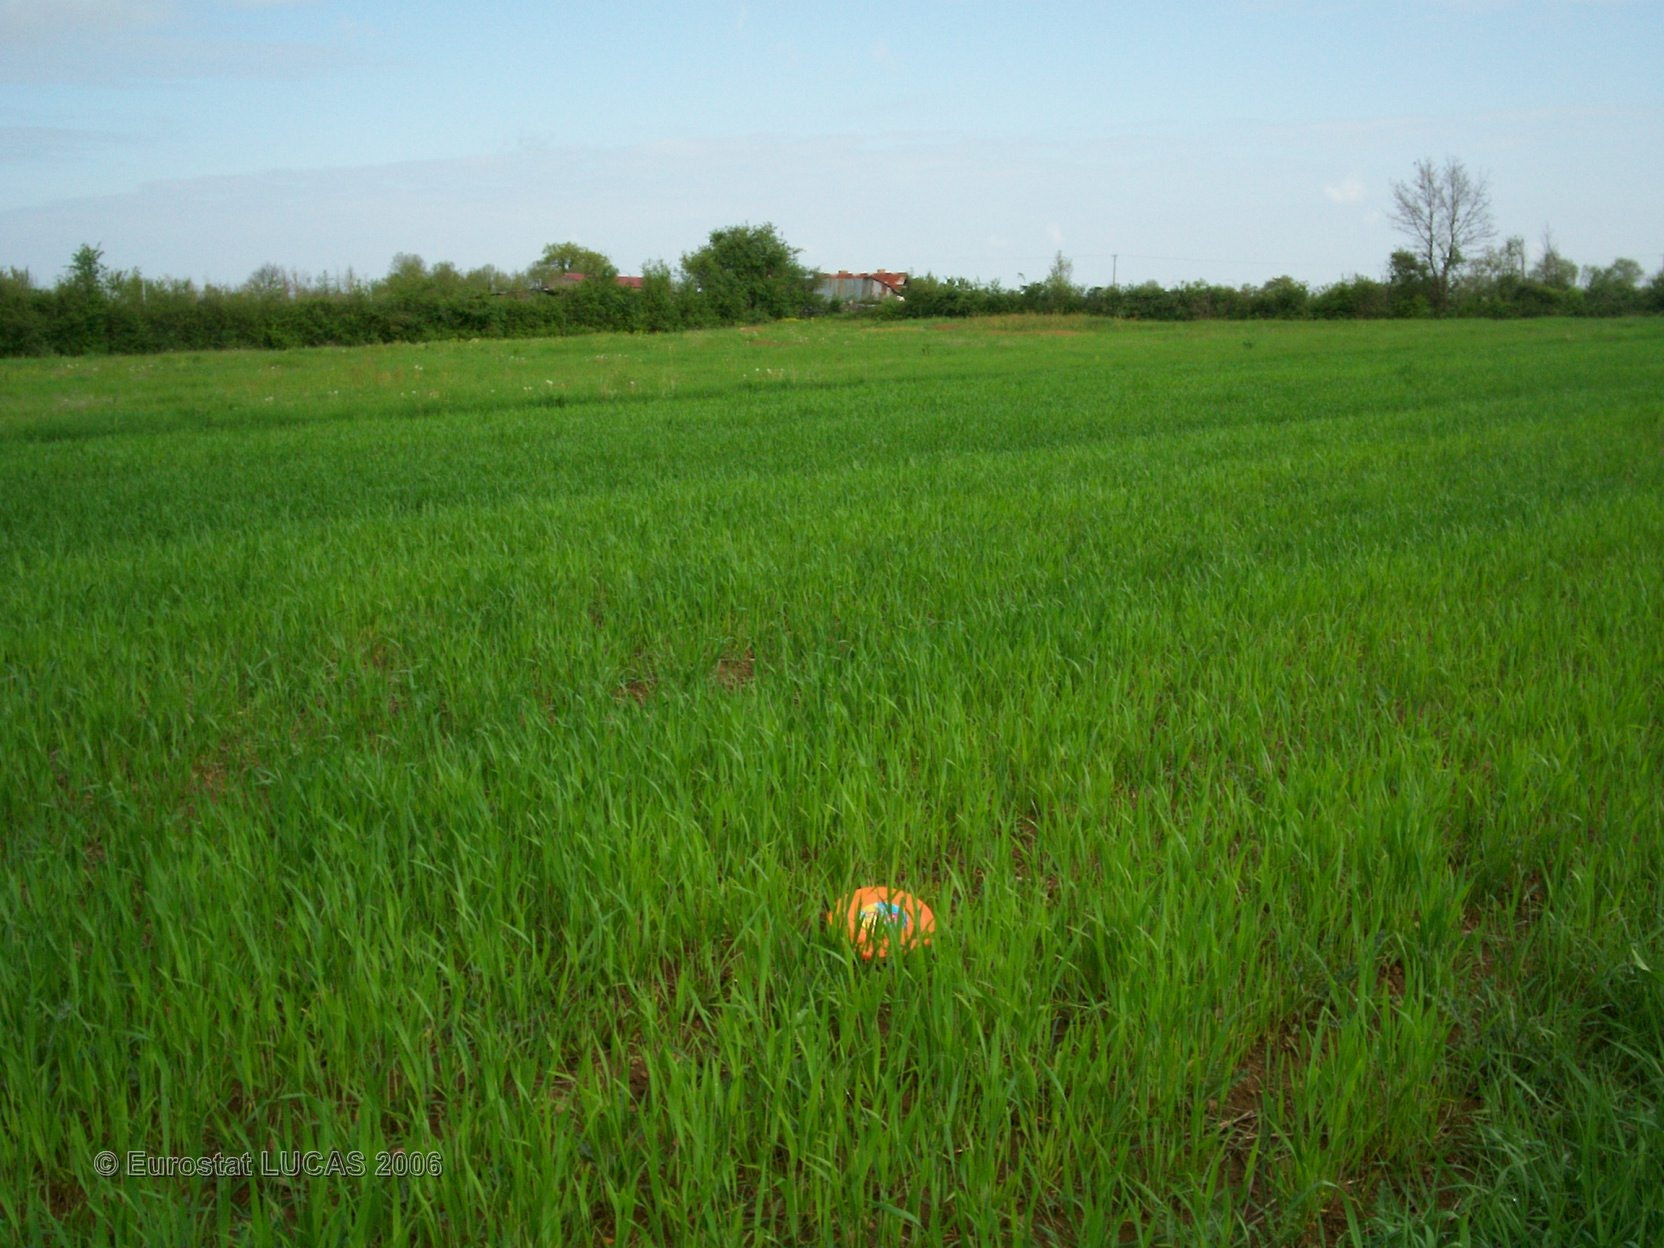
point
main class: Cropland
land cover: Common wheat
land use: Agriculture (excluding fallow land and kitchen gardens)
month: April
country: FR
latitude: 47.0116
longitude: -0.3267
